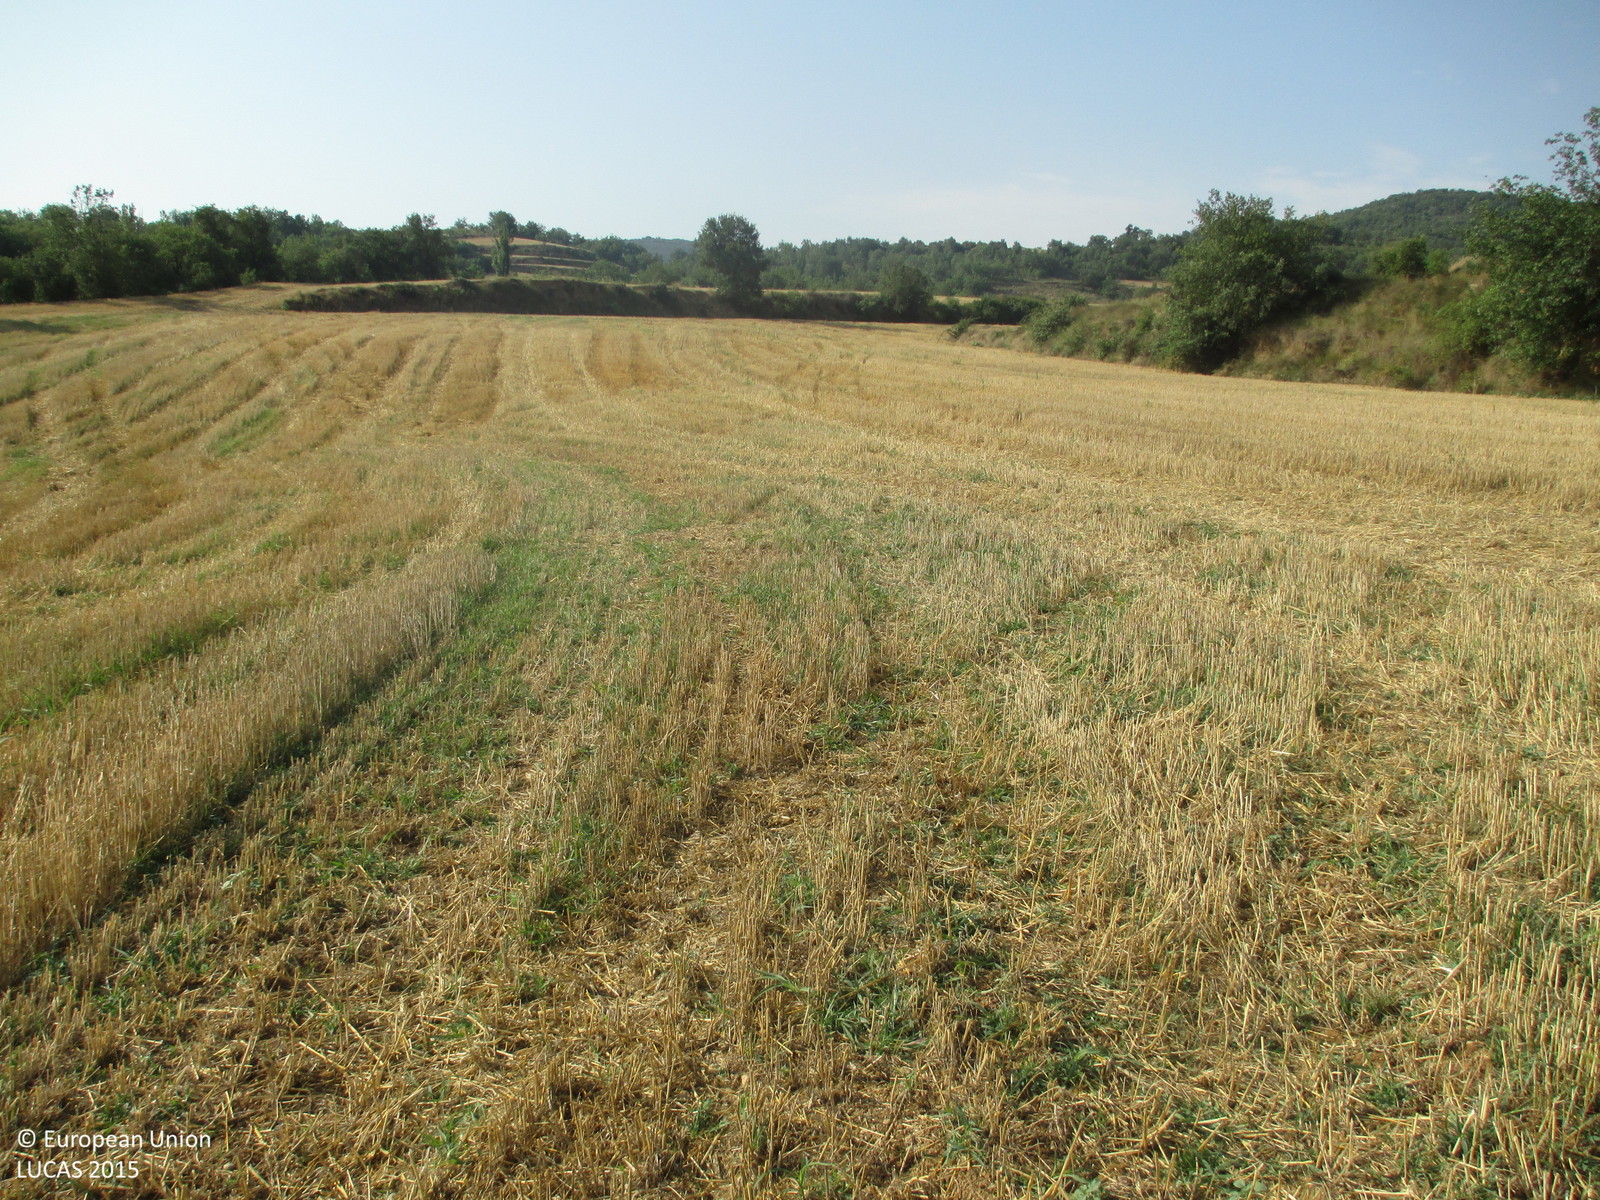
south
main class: Cropland
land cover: Common wheat
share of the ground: < 10 %
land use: Agriculture (excluding fallow land and kitchen gardens)
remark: Harvested field
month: July
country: ES
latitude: 42.1188
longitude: 0.3424
